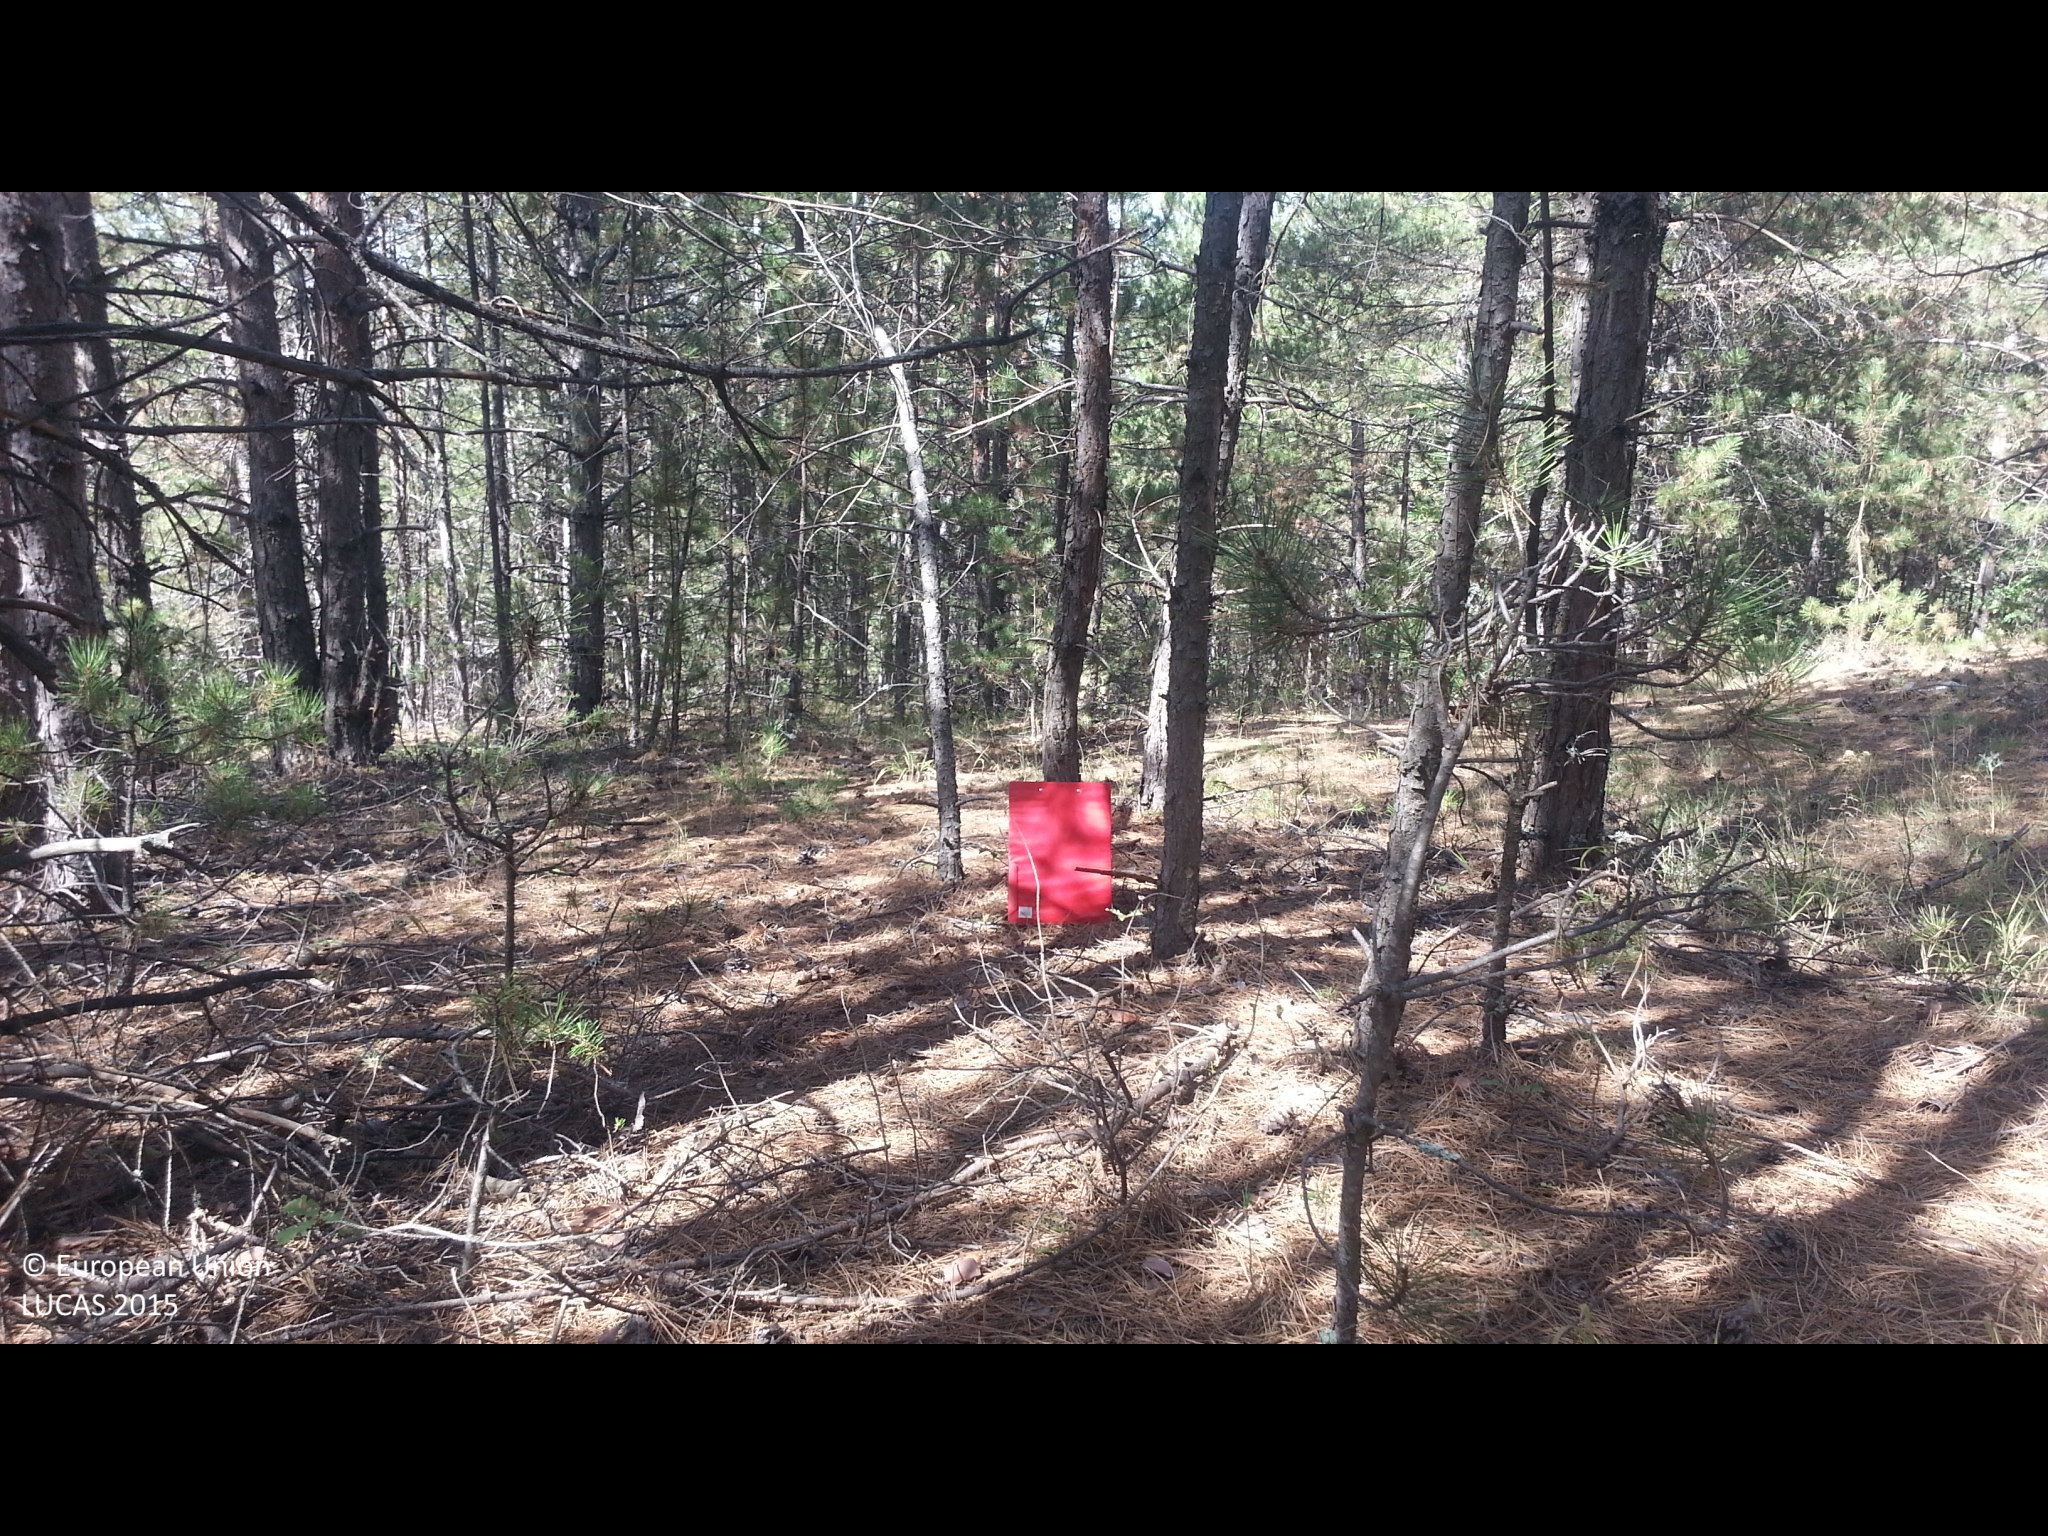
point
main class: Woodland
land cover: Pine dominated coniferous woodland
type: hemiboreal forest and nemoral coniferous forest and mixed broadleaved-coniferous forest
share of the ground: > 75 %
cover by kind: coniferous forest trees 85 %, shrubs 10 %, unconsolidated bare surface 5 %
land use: Forestry
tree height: > 5 m
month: September
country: BG
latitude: 42.1410
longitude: 22.8601
